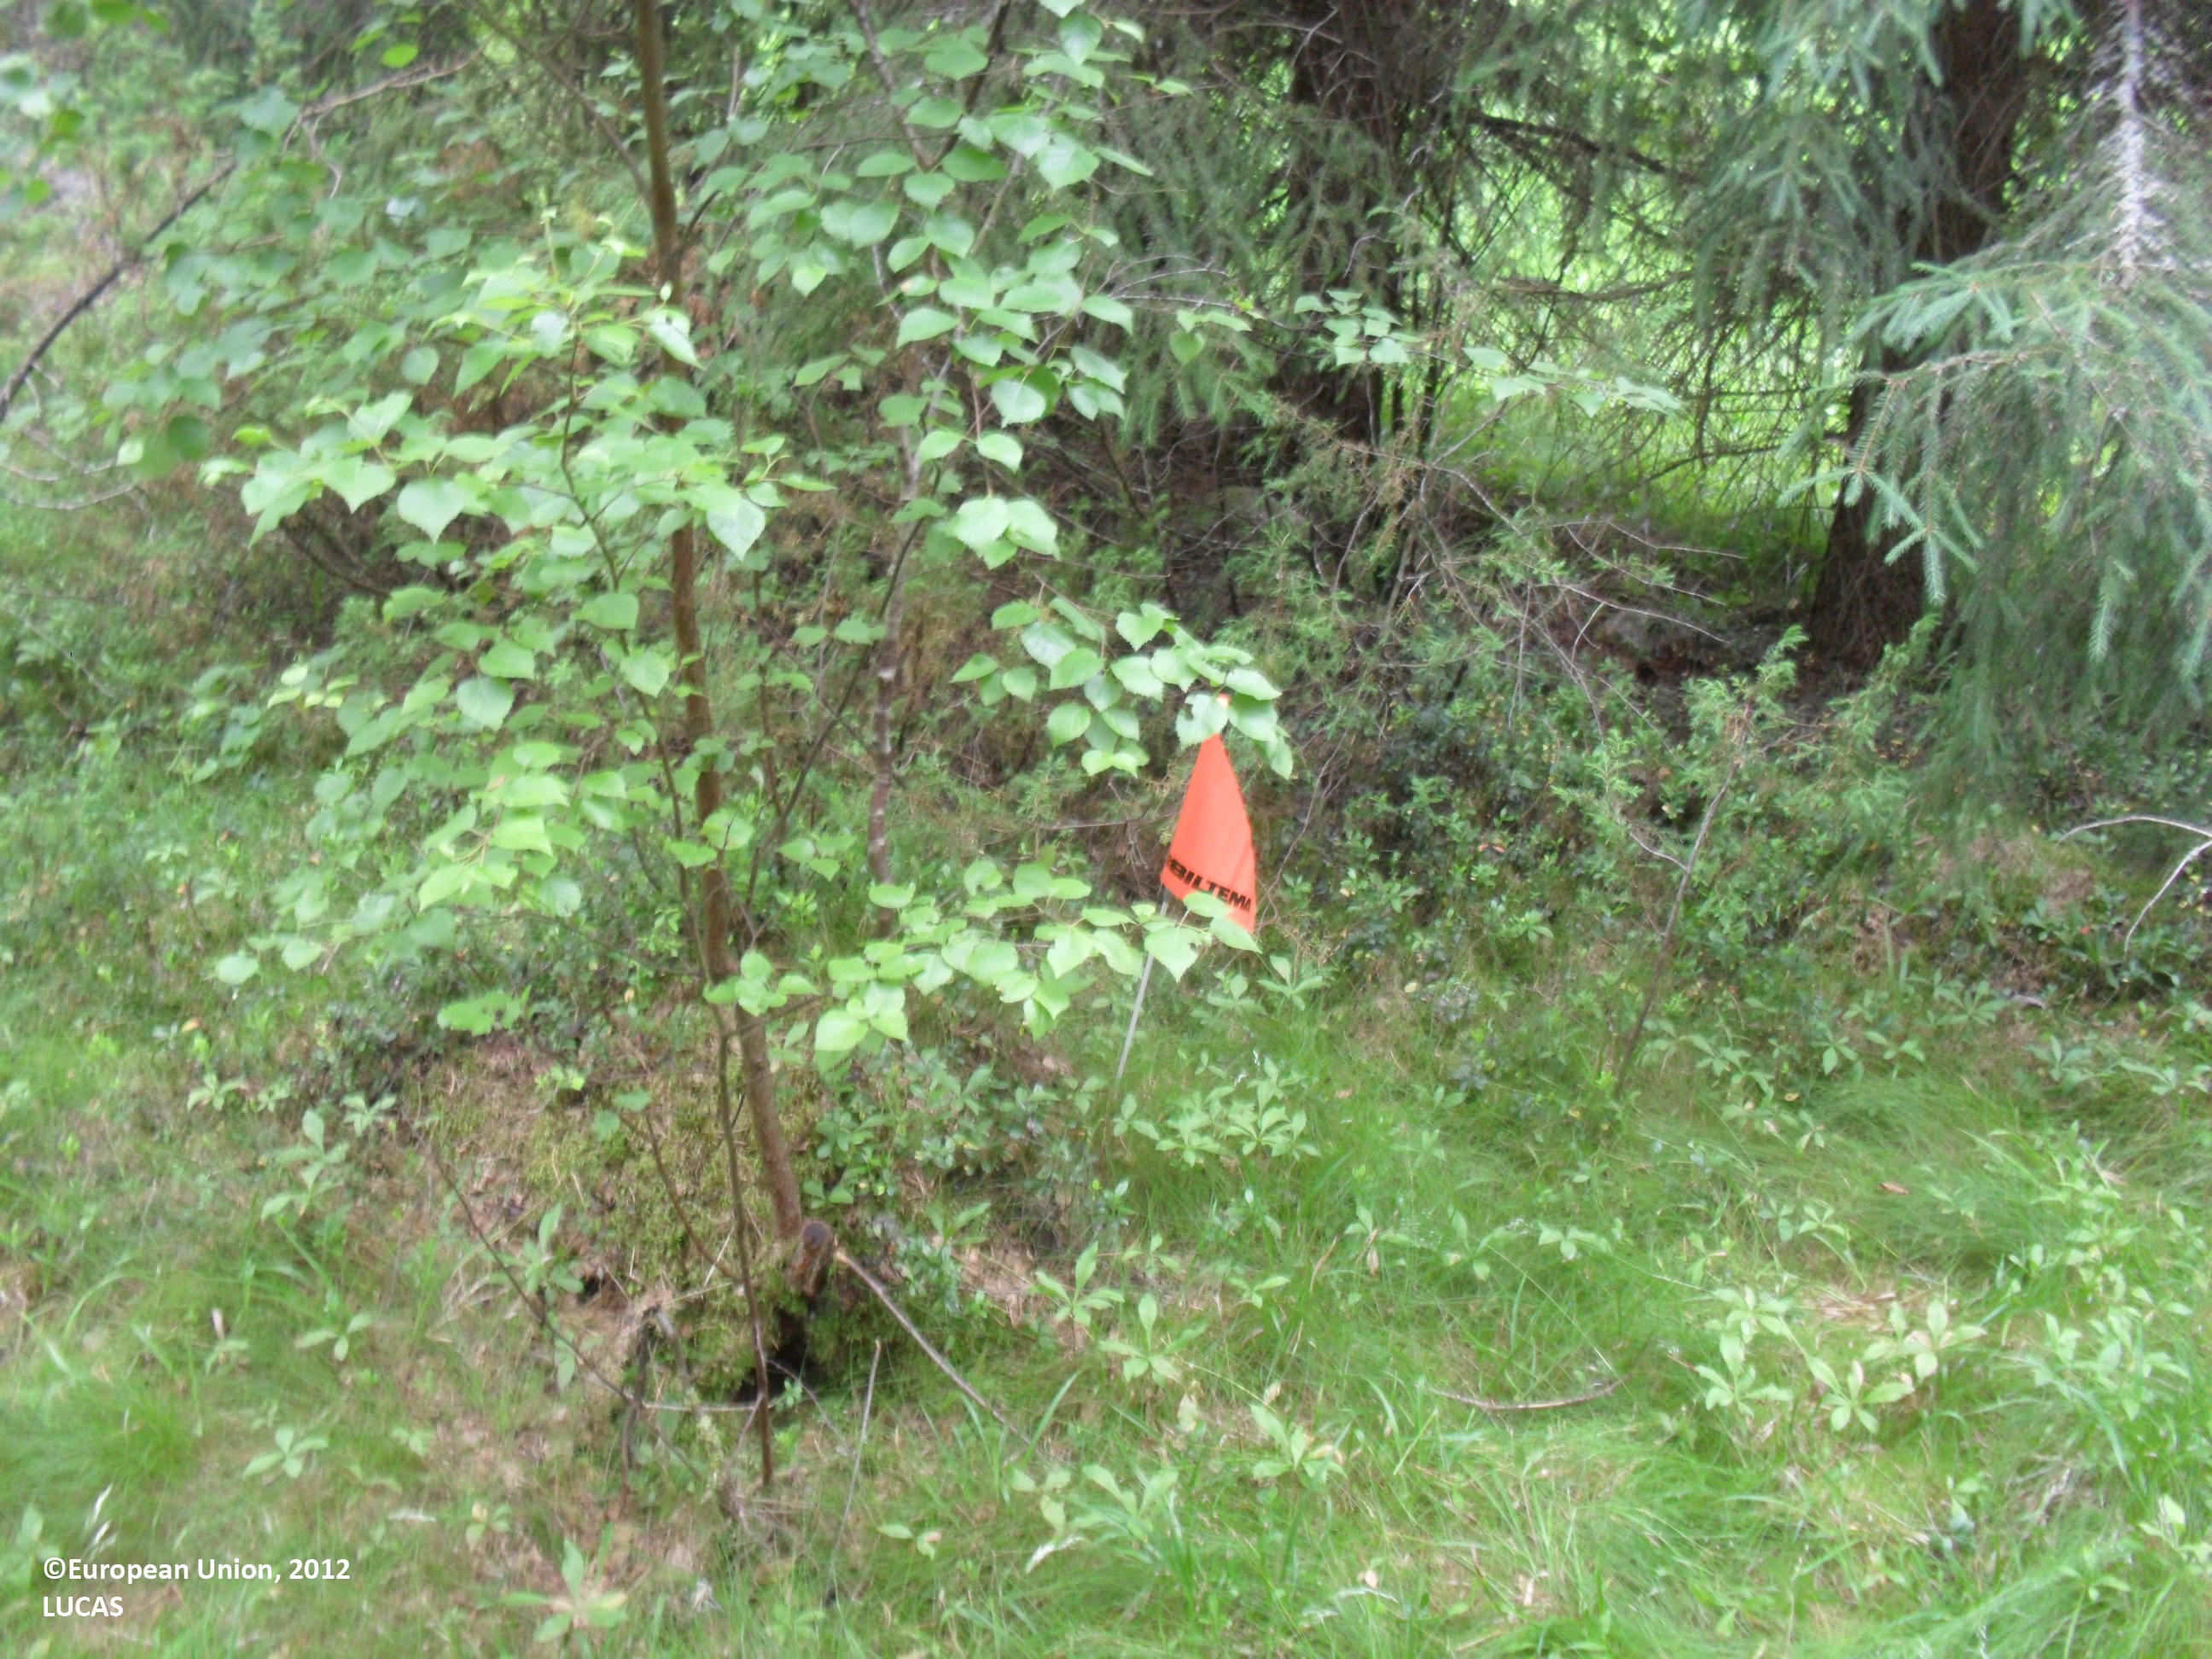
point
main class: Woodland
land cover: Pine dominated mixed woodland
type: boreal forest
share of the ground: 50 - 75 %
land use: Forestry
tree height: > 5 m
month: July
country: FI
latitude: 63.5832
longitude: 23.6627
